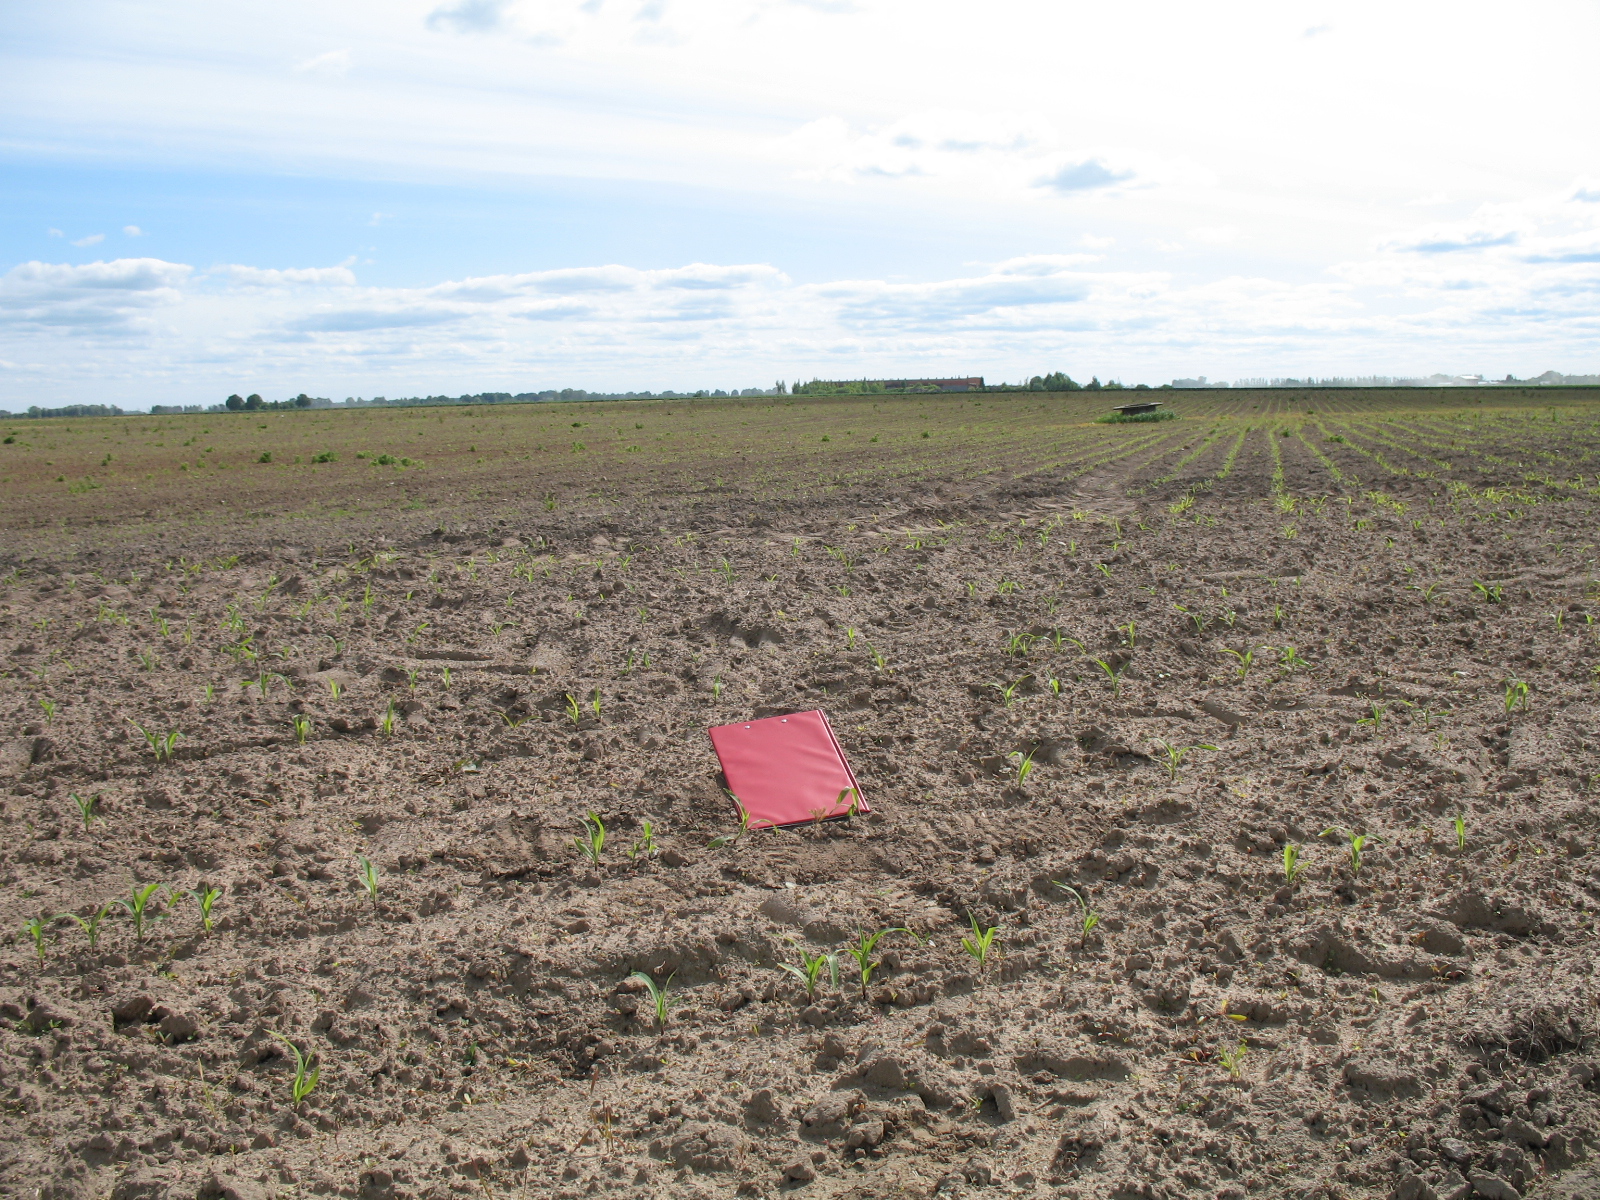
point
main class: Cropland
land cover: Maize
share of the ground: < 10 %
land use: Agriculture (excluding fallow land and kitchen gardens)
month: June
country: LV
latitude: 56.6218
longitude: 23.4873
